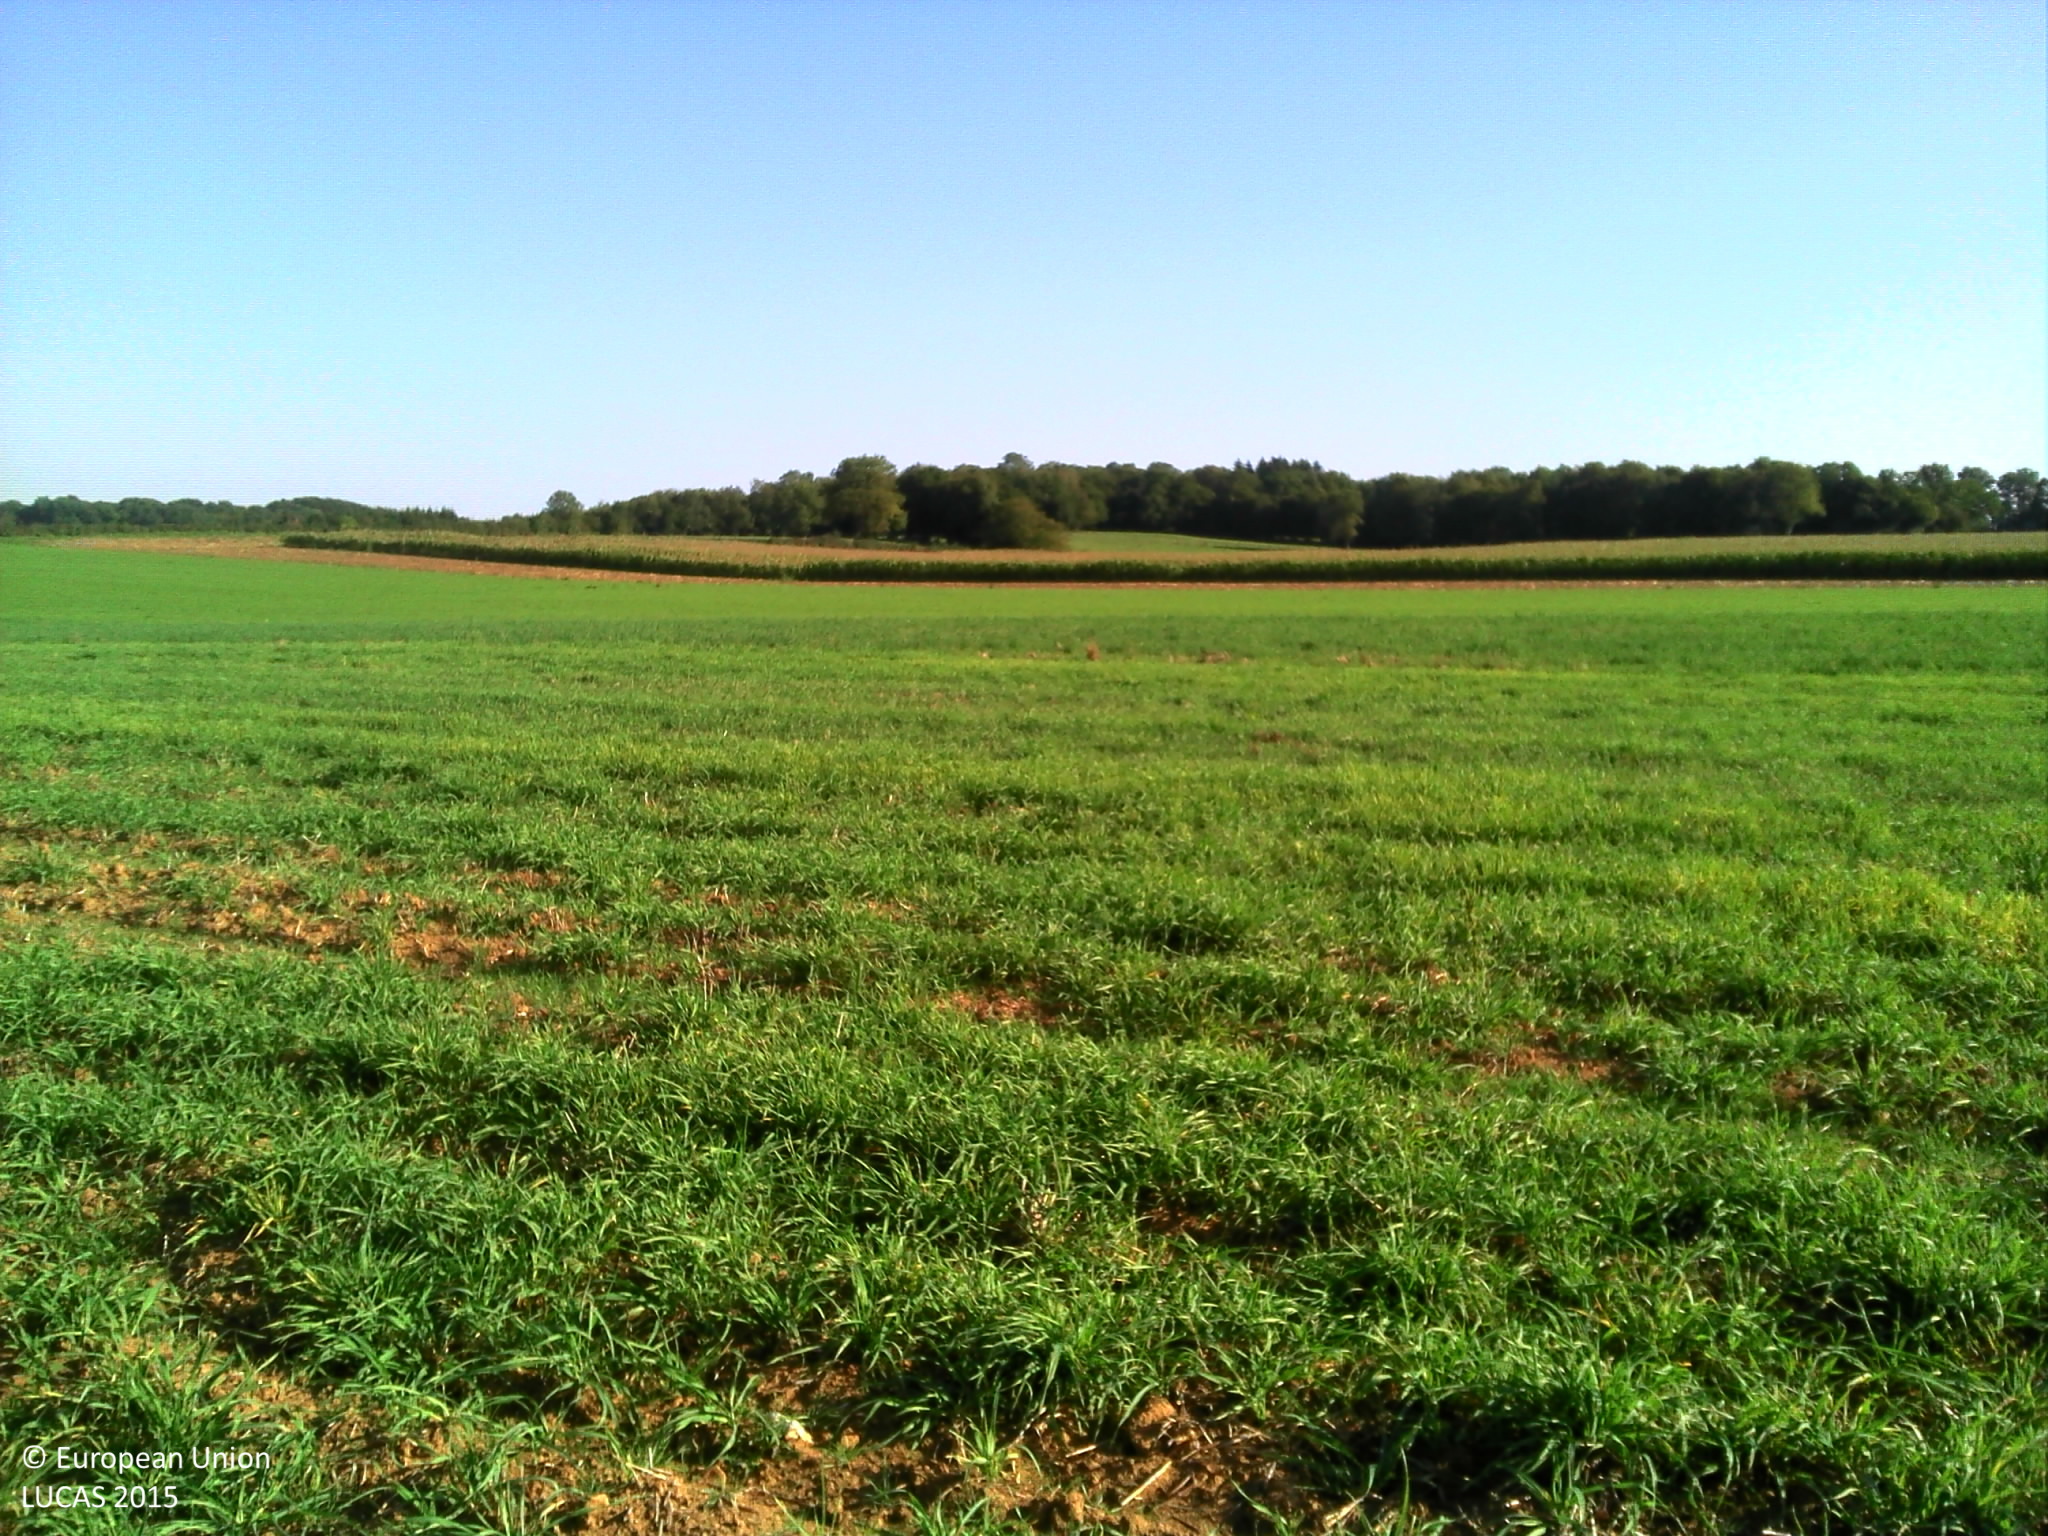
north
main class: Cropland
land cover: Temporary grasslands
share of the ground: > 75 %
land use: Agriculture (excluding fallow land and kitchen gardens)
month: September
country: FR
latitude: 47.2800
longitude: 6.3398
